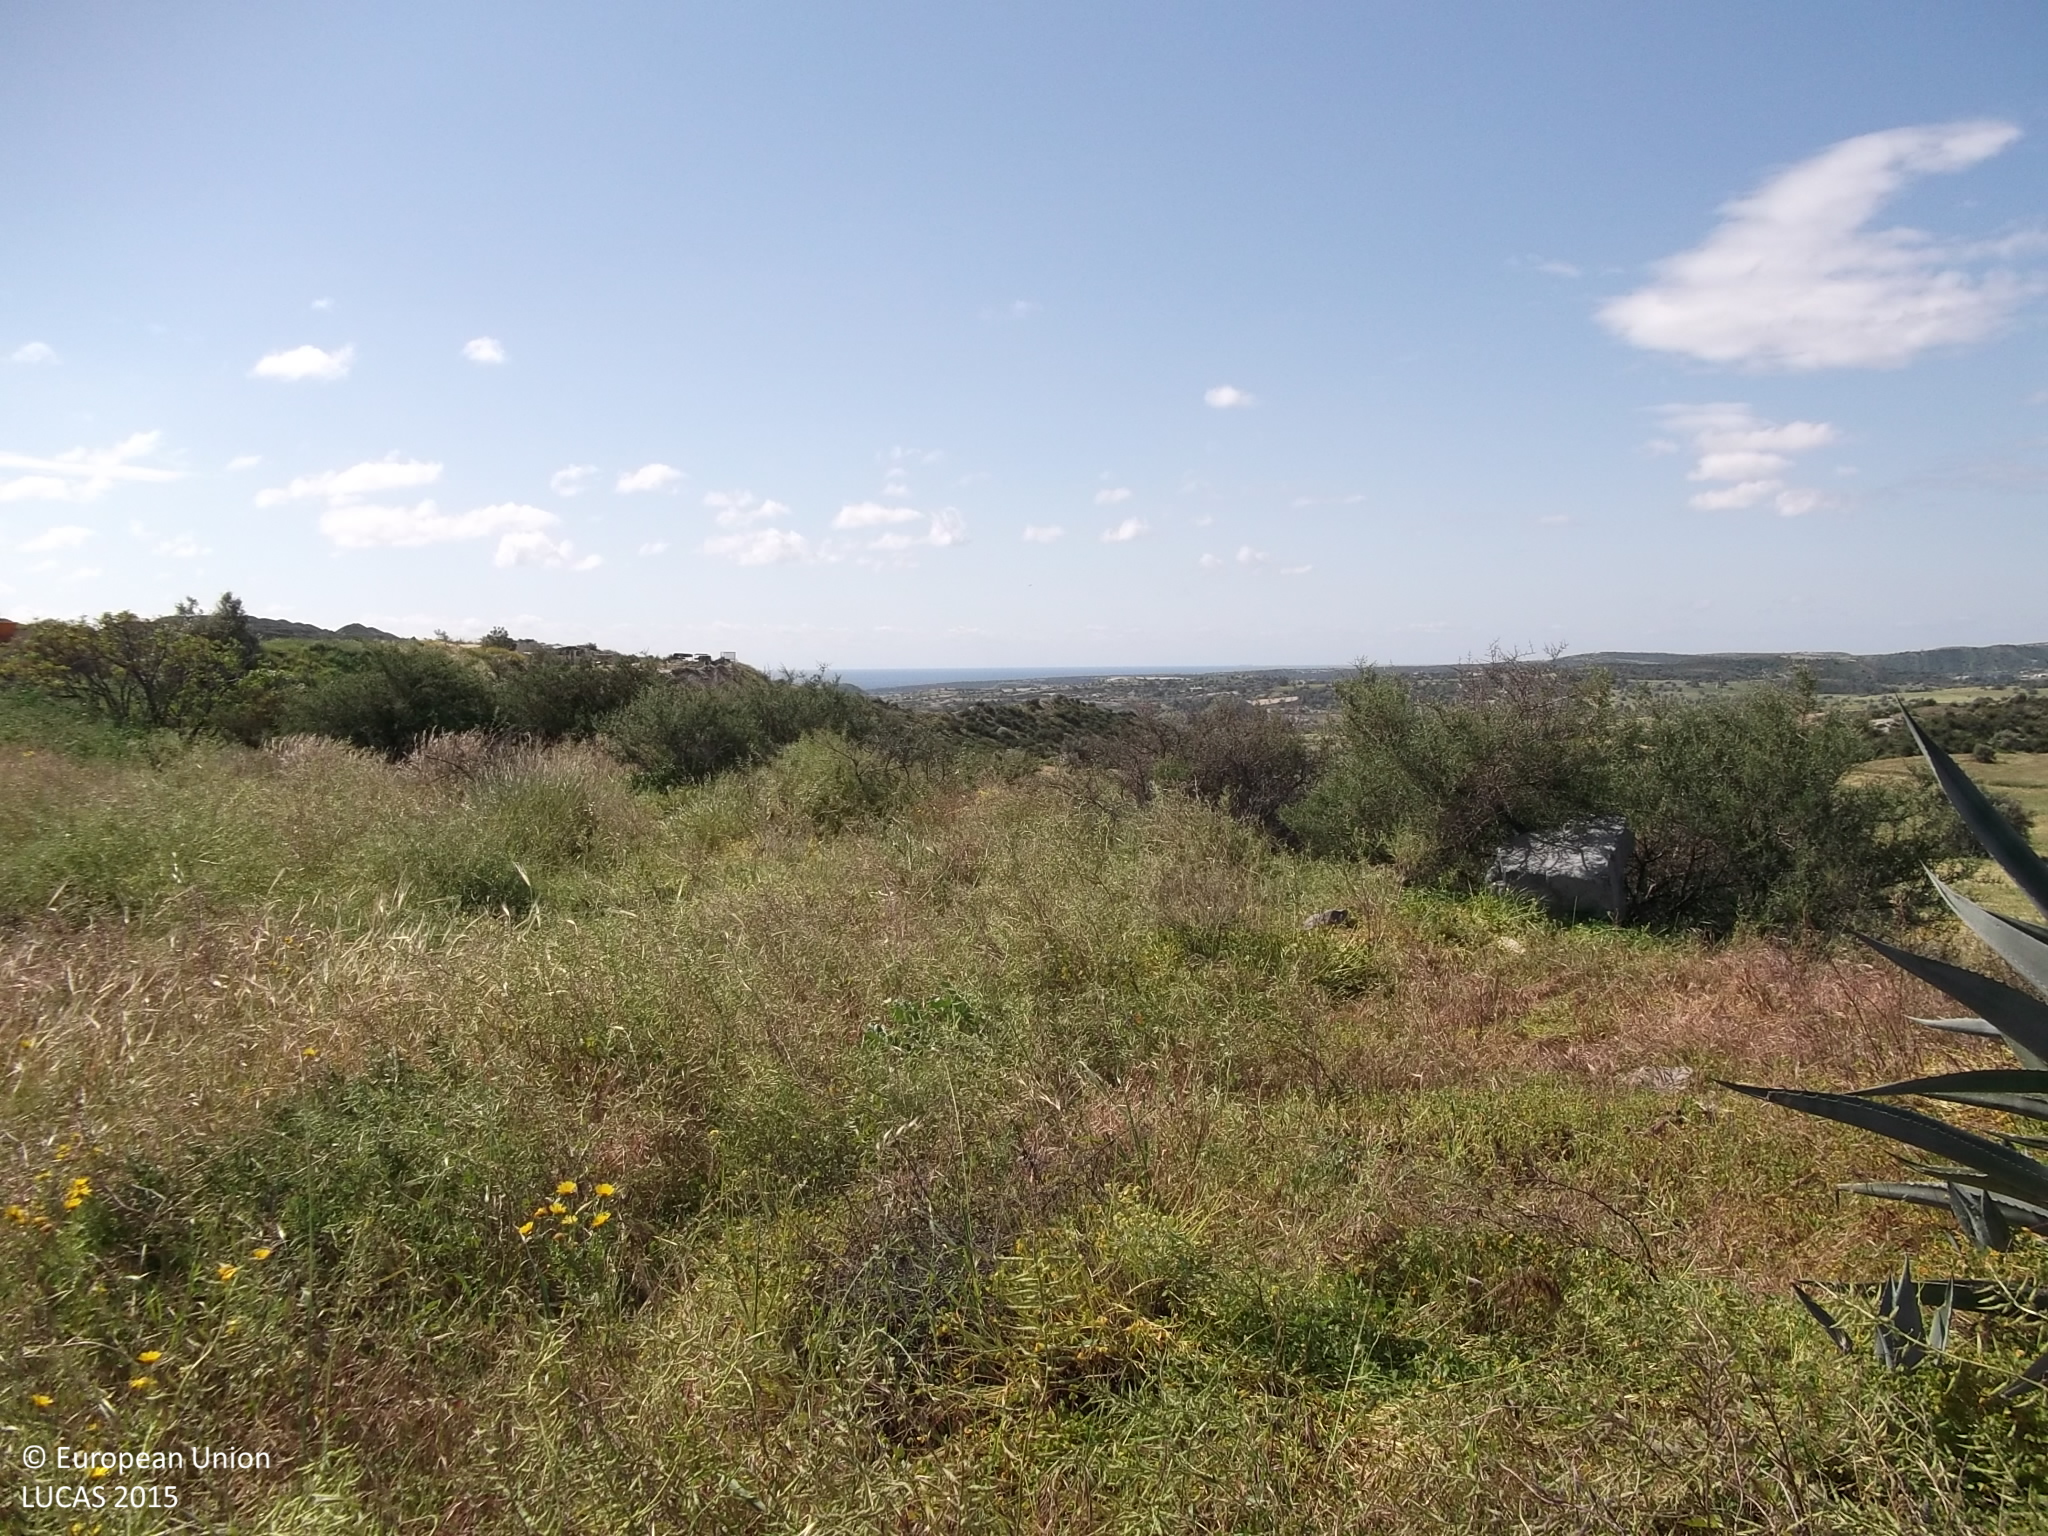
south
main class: Shrubland
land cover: Shrubland without tree cover
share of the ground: > 75 %
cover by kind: shrubs 70 %, herbaceous plants 30 %
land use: Semi-natural and natural areas not in use
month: April
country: CY
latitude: 34.8470
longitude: 33.4484
